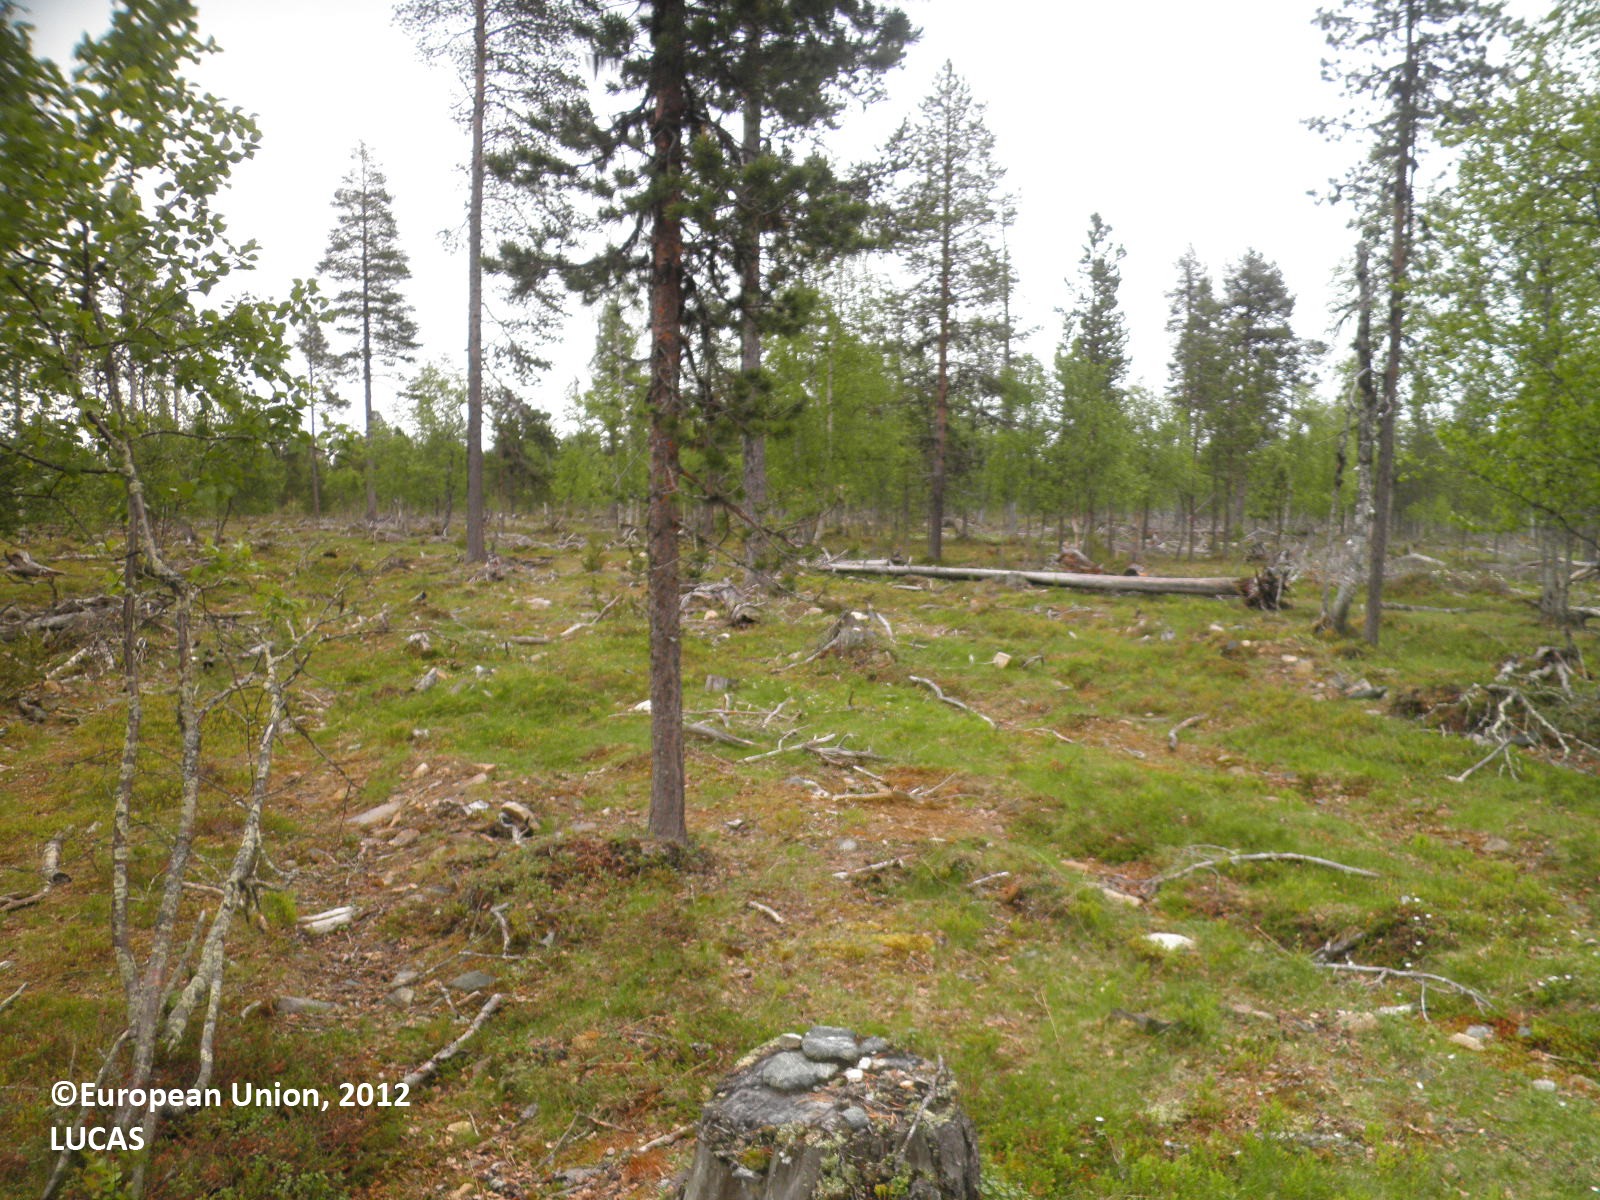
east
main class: Woodland
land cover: Pine dominated mixed woodland
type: boreal forest
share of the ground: 10 - 25 %
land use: Forestry
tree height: > 5 m
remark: Harvested field
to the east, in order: Pine dominated mixed woodland; Pine dominated coniferous woodland; Pine dominated mixed woodland
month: July
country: FI
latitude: 68.4188
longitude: 25.8524
